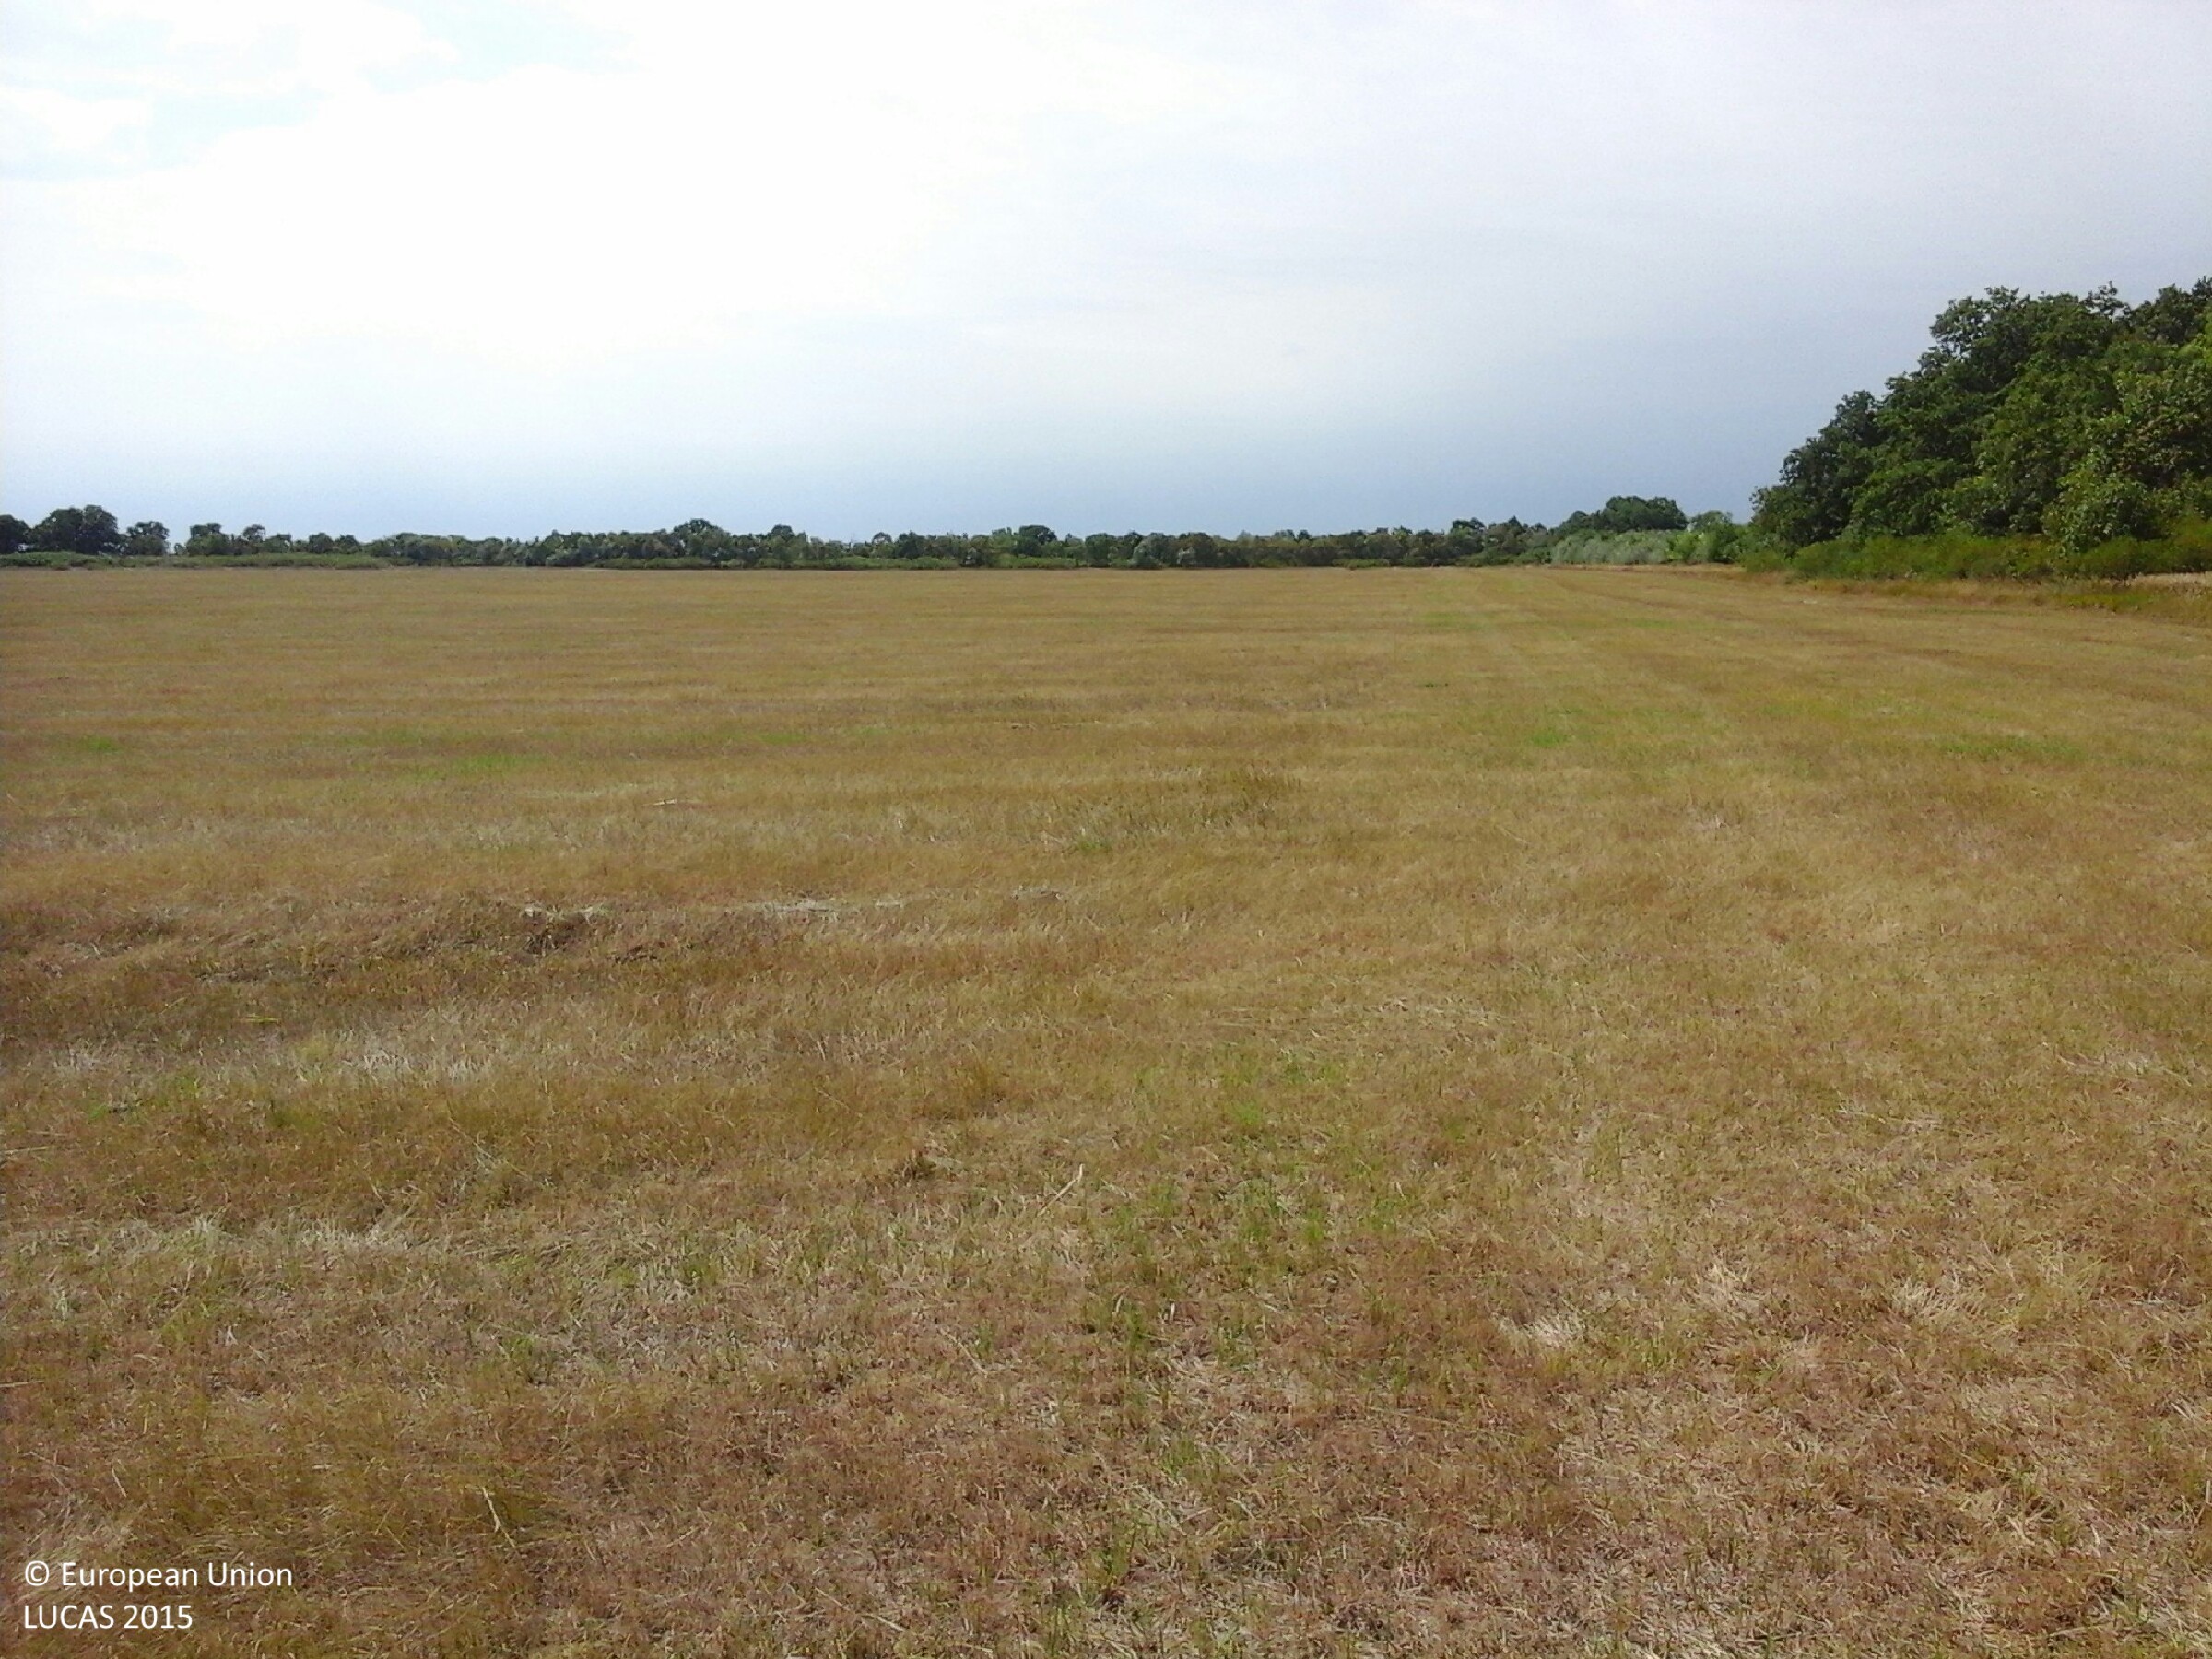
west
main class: Grassland
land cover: Grassland without tree/shrub cover
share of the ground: > 75 %
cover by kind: herbaceous plants 100 %
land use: Agriculture (excluding fallow land and kitchen gardens)
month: July
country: HU
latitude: 47.4566
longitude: 20.6036
